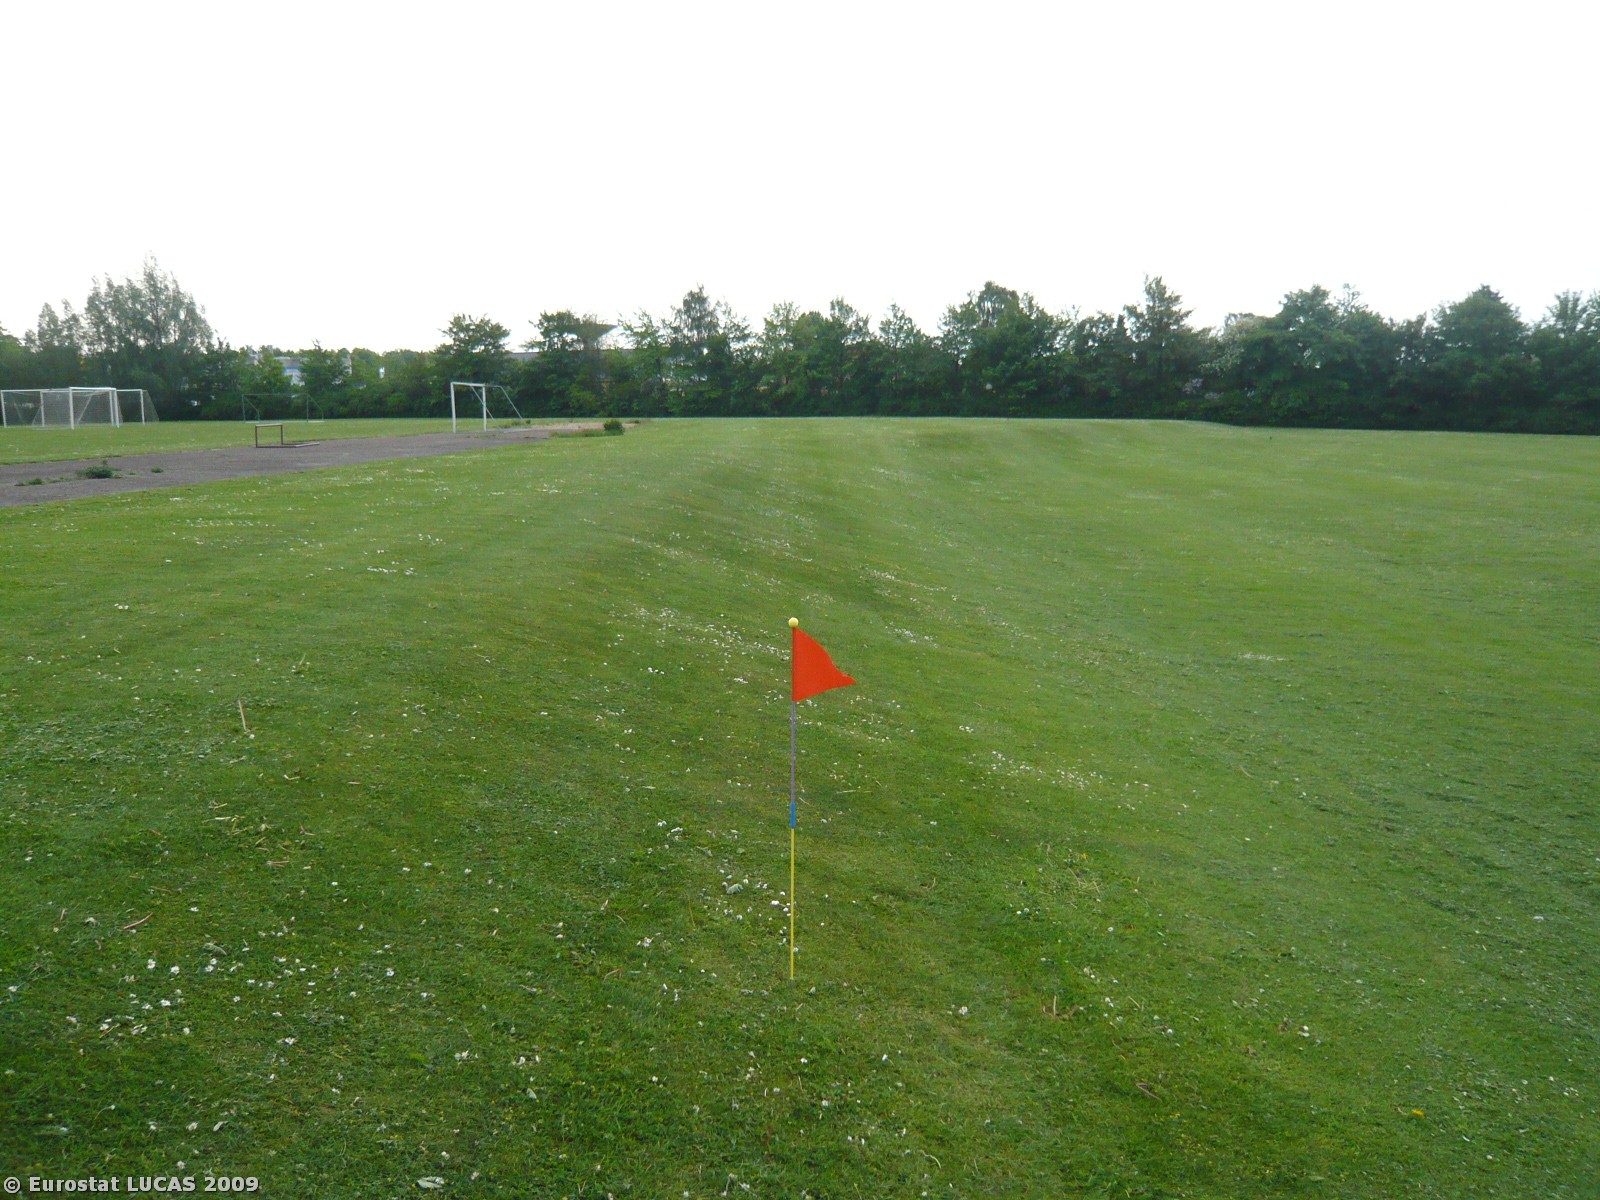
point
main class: Grassland
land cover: Grassland without tree/shrub cover
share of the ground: > 75 %
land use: Sport
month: May
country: DK
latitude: 55.2406
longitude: 11.7758
